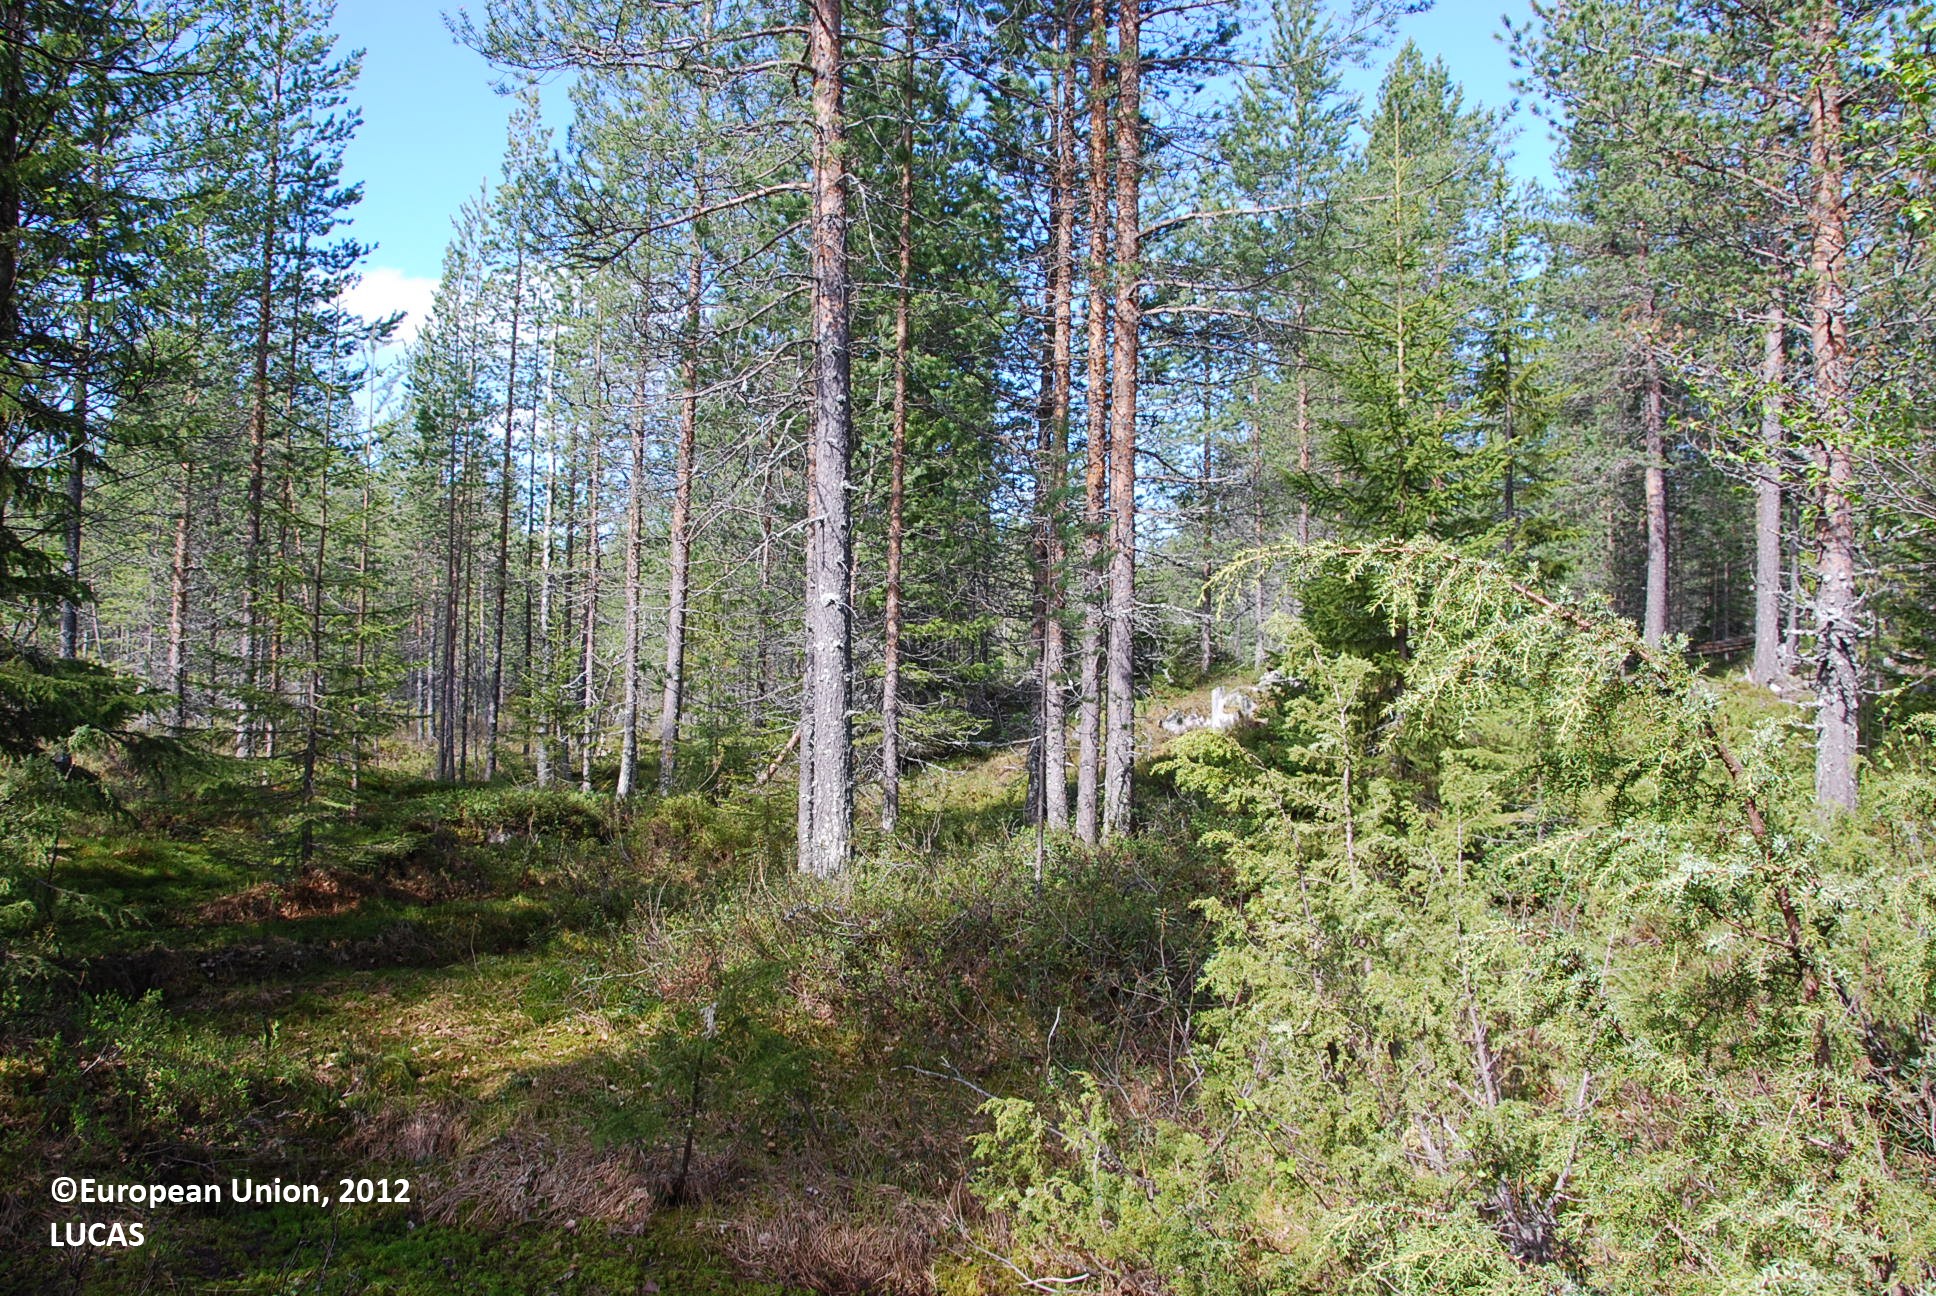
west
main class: Woodland
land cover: Other mixed woodland
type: boreal forest
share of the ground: > 75 %
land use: Forestry
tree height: > 5 m
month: June
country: FI
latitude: 66.3406
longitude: 27.8357
